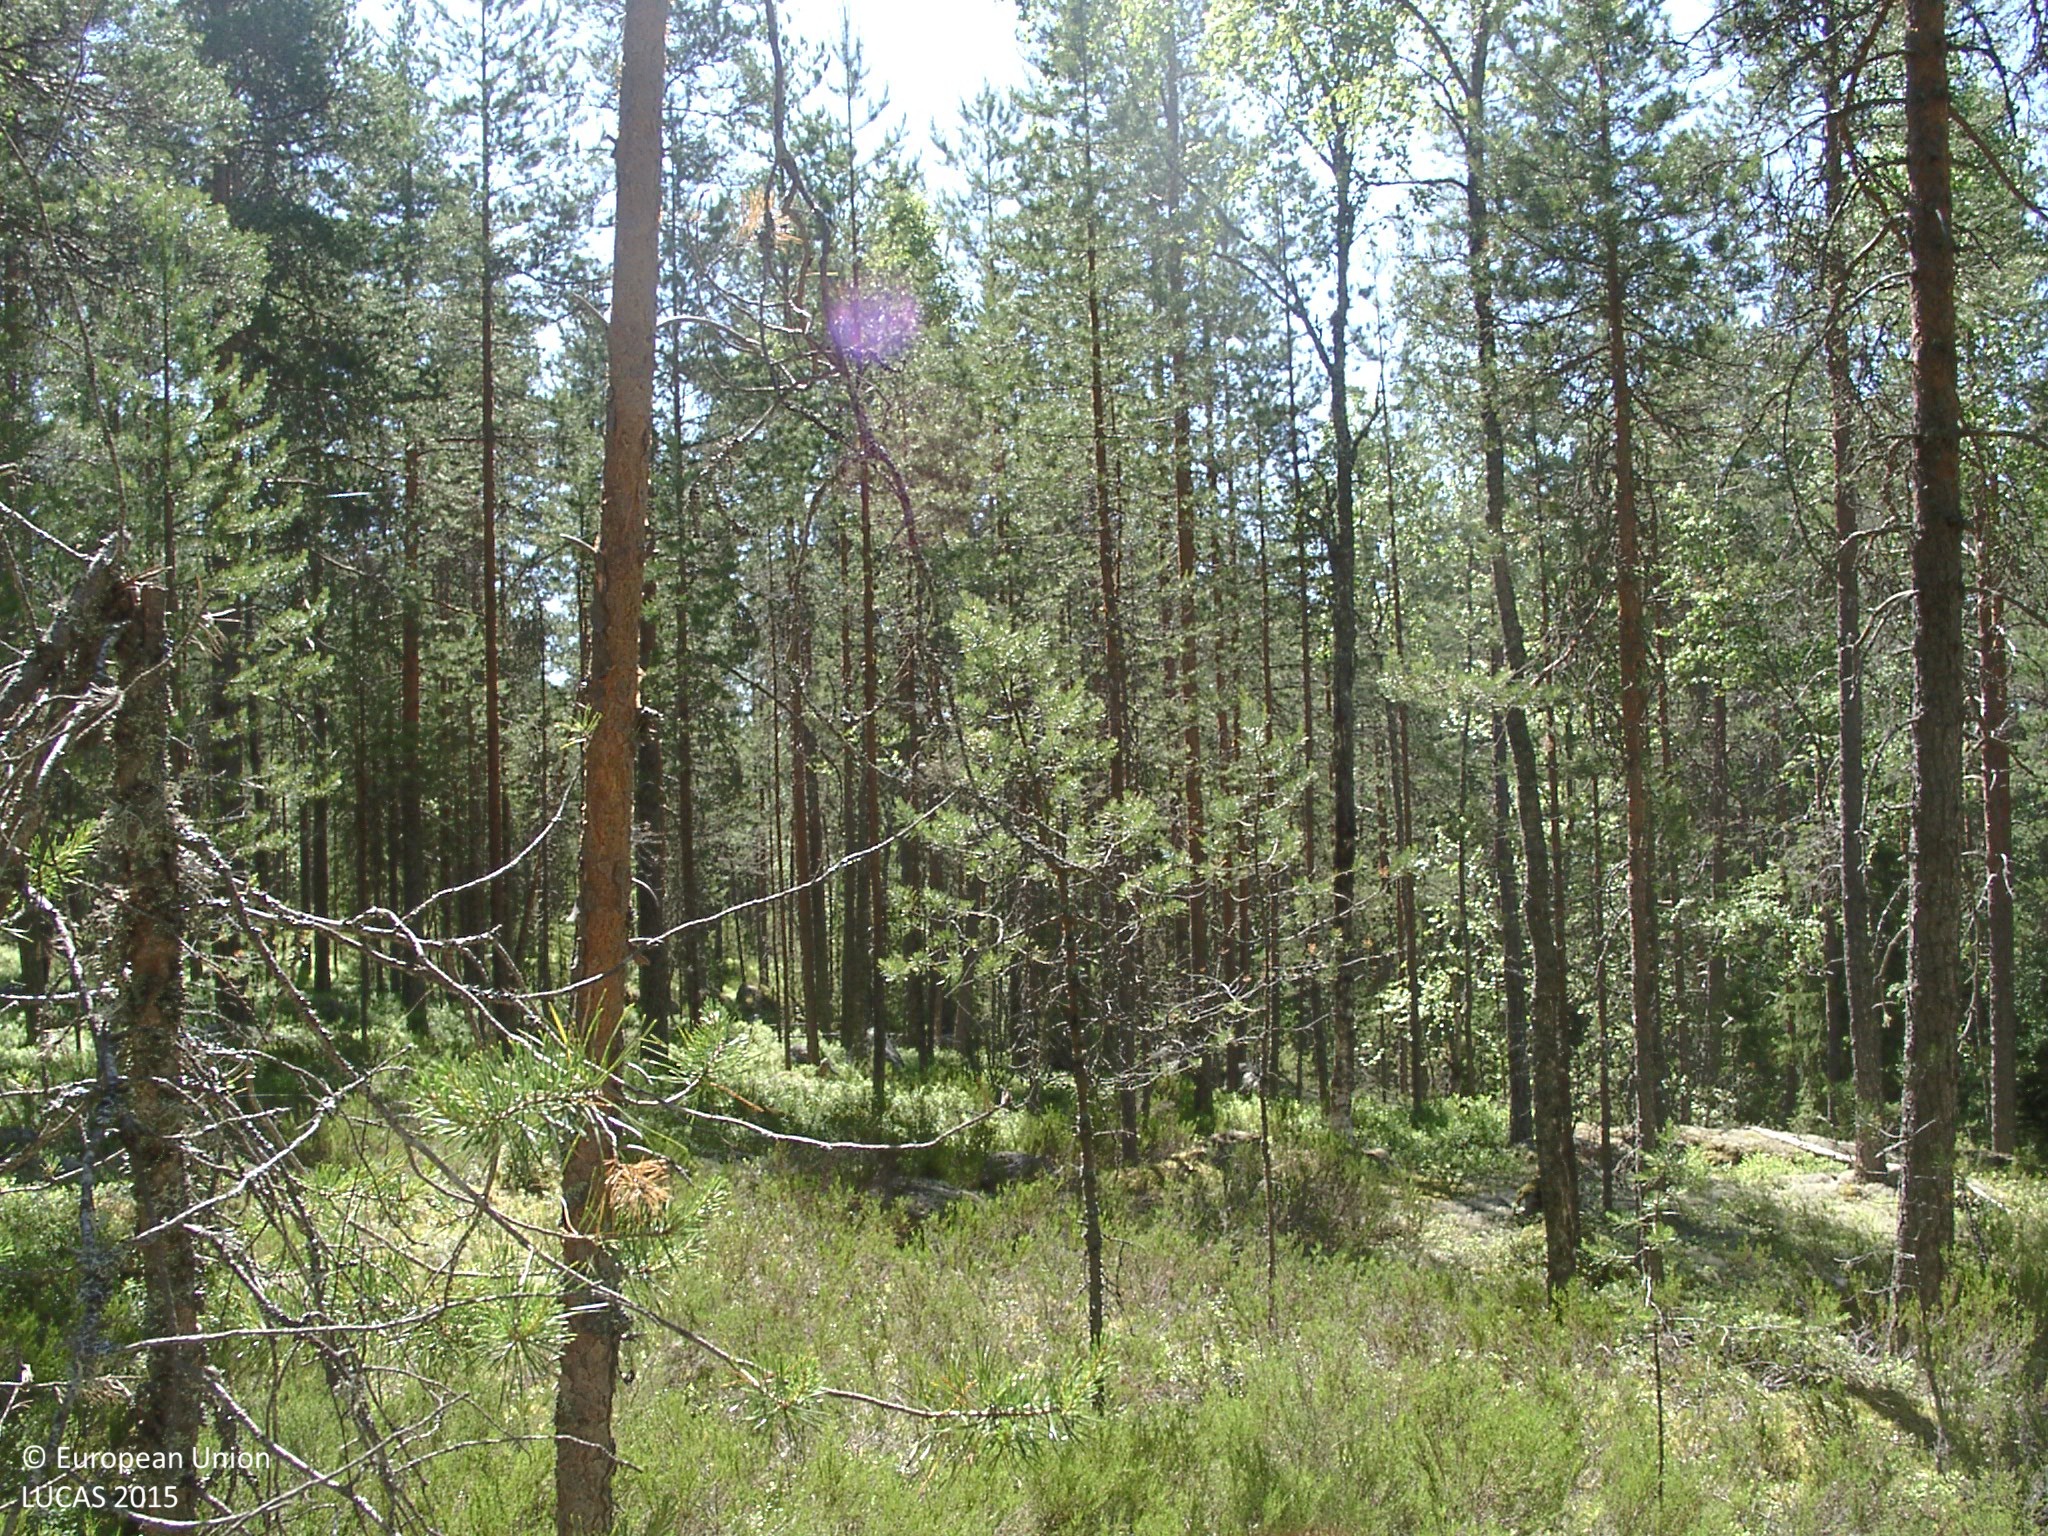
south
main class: Woodland
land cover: Pine dominated coniferous woodland
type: boreal forest
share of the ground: 50 - 75 %
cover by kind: coniferous forest trees 50 %, shrubs 30 %, lichens and mosses 10 %, broadleaved forest trees 5 %, consolidated bare surface 5 %
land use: Semi-natural and natural areas not in use
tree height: > 5 m
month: July
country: FI
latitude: 61.9808
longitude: 25.5553
